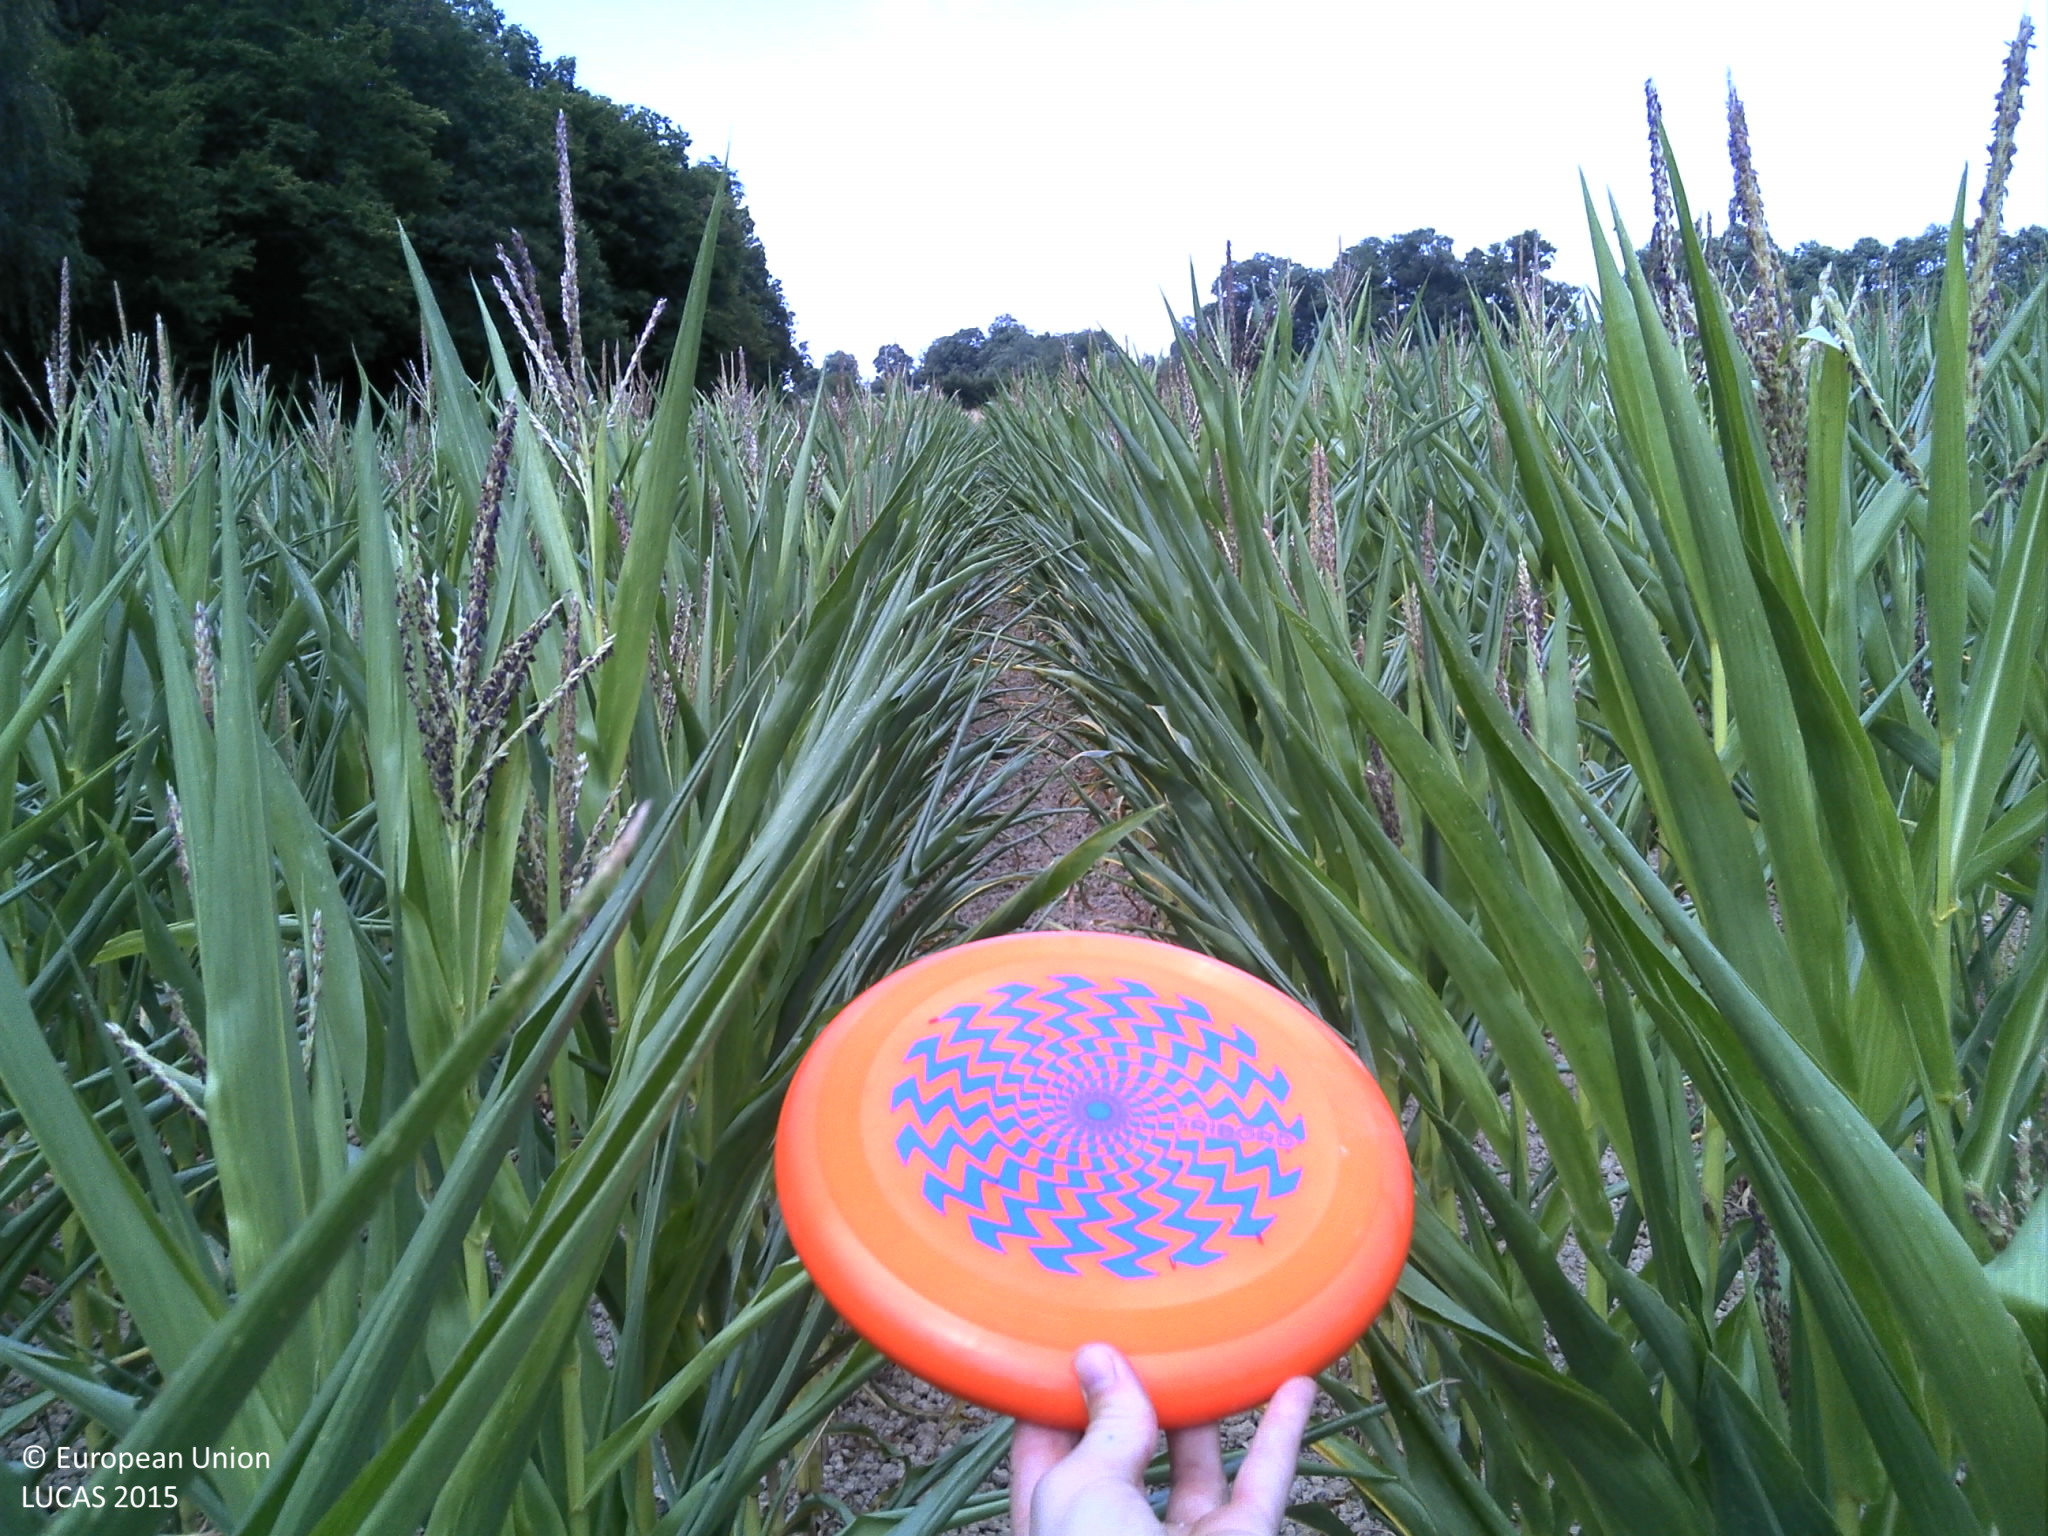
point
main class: Cropland
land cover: Maize
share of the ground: > 75 %
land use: Agriculture (excluding fallow land and kitchen gardens)
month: July
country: FR
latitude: 48.8608
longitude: 4.8589
